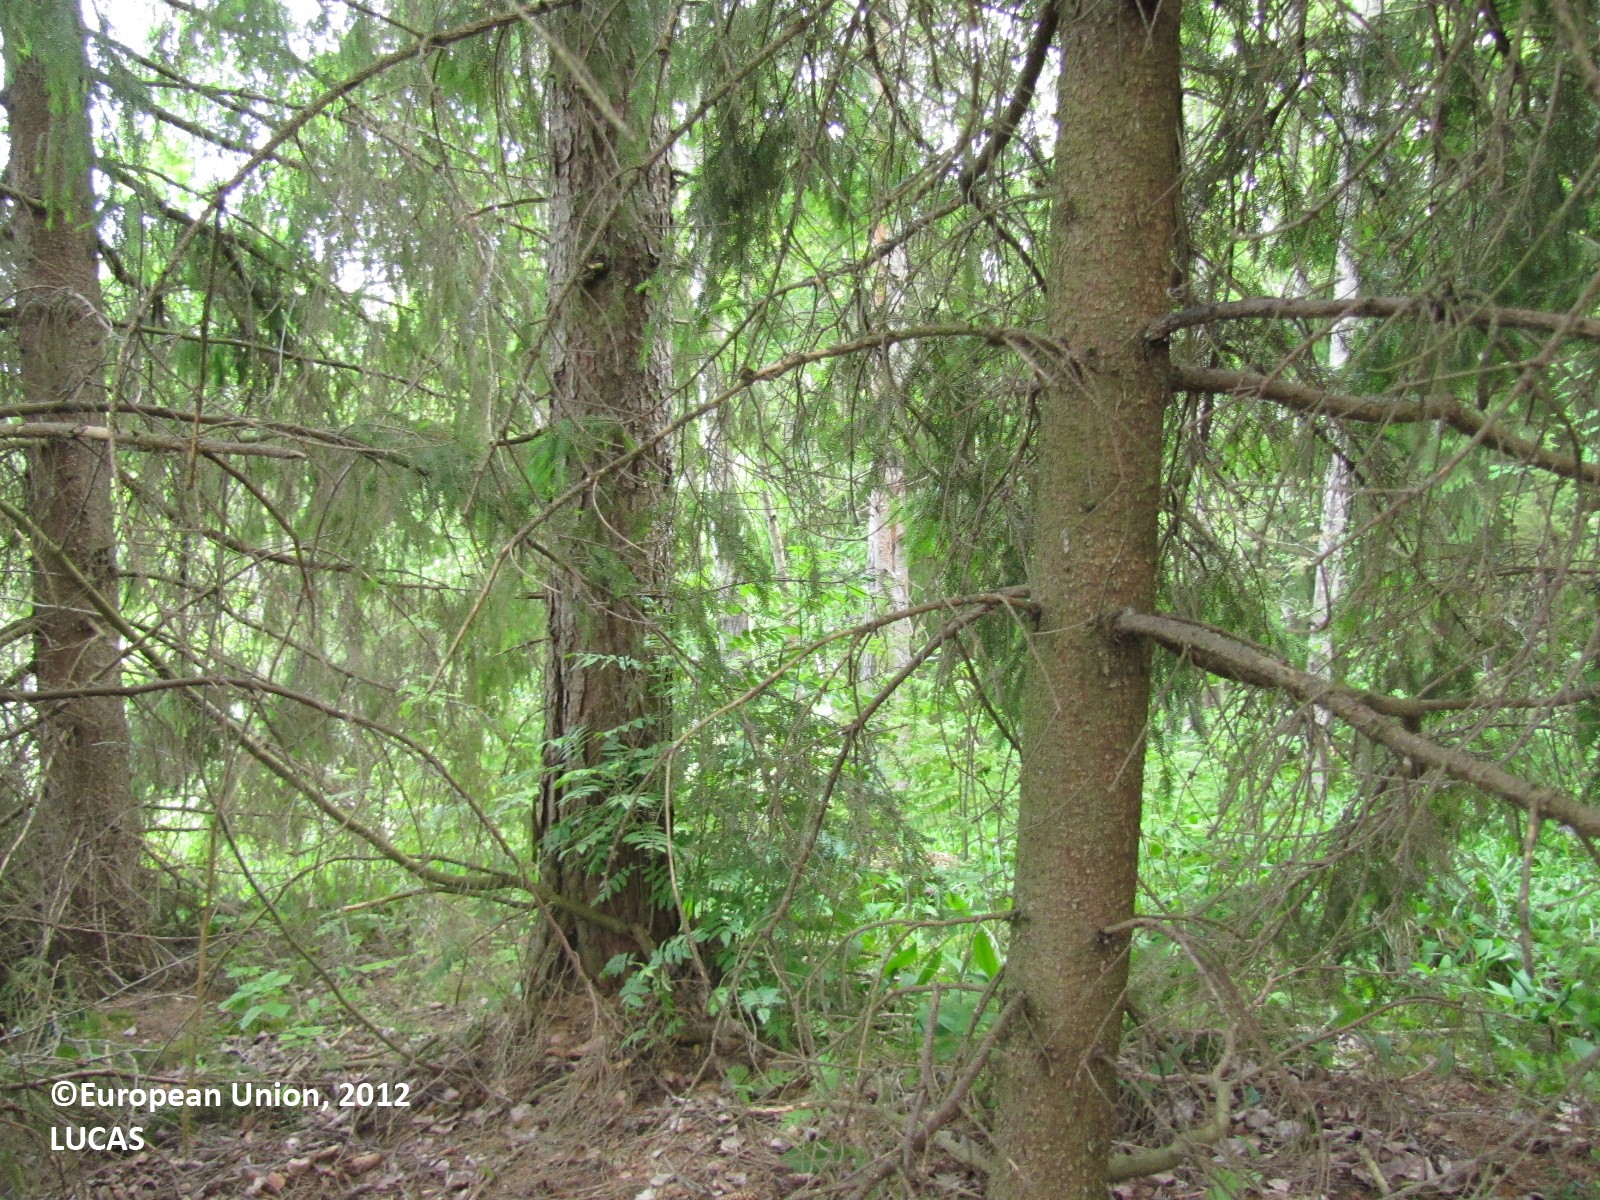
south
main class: Woodland
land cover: Spruce dominated coniferous woodland
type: boreal forest
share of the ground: 25 - 50 %
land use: Forestry
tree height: > 5 m
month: June
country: FI
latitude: 61.4897
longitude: 24.4266
